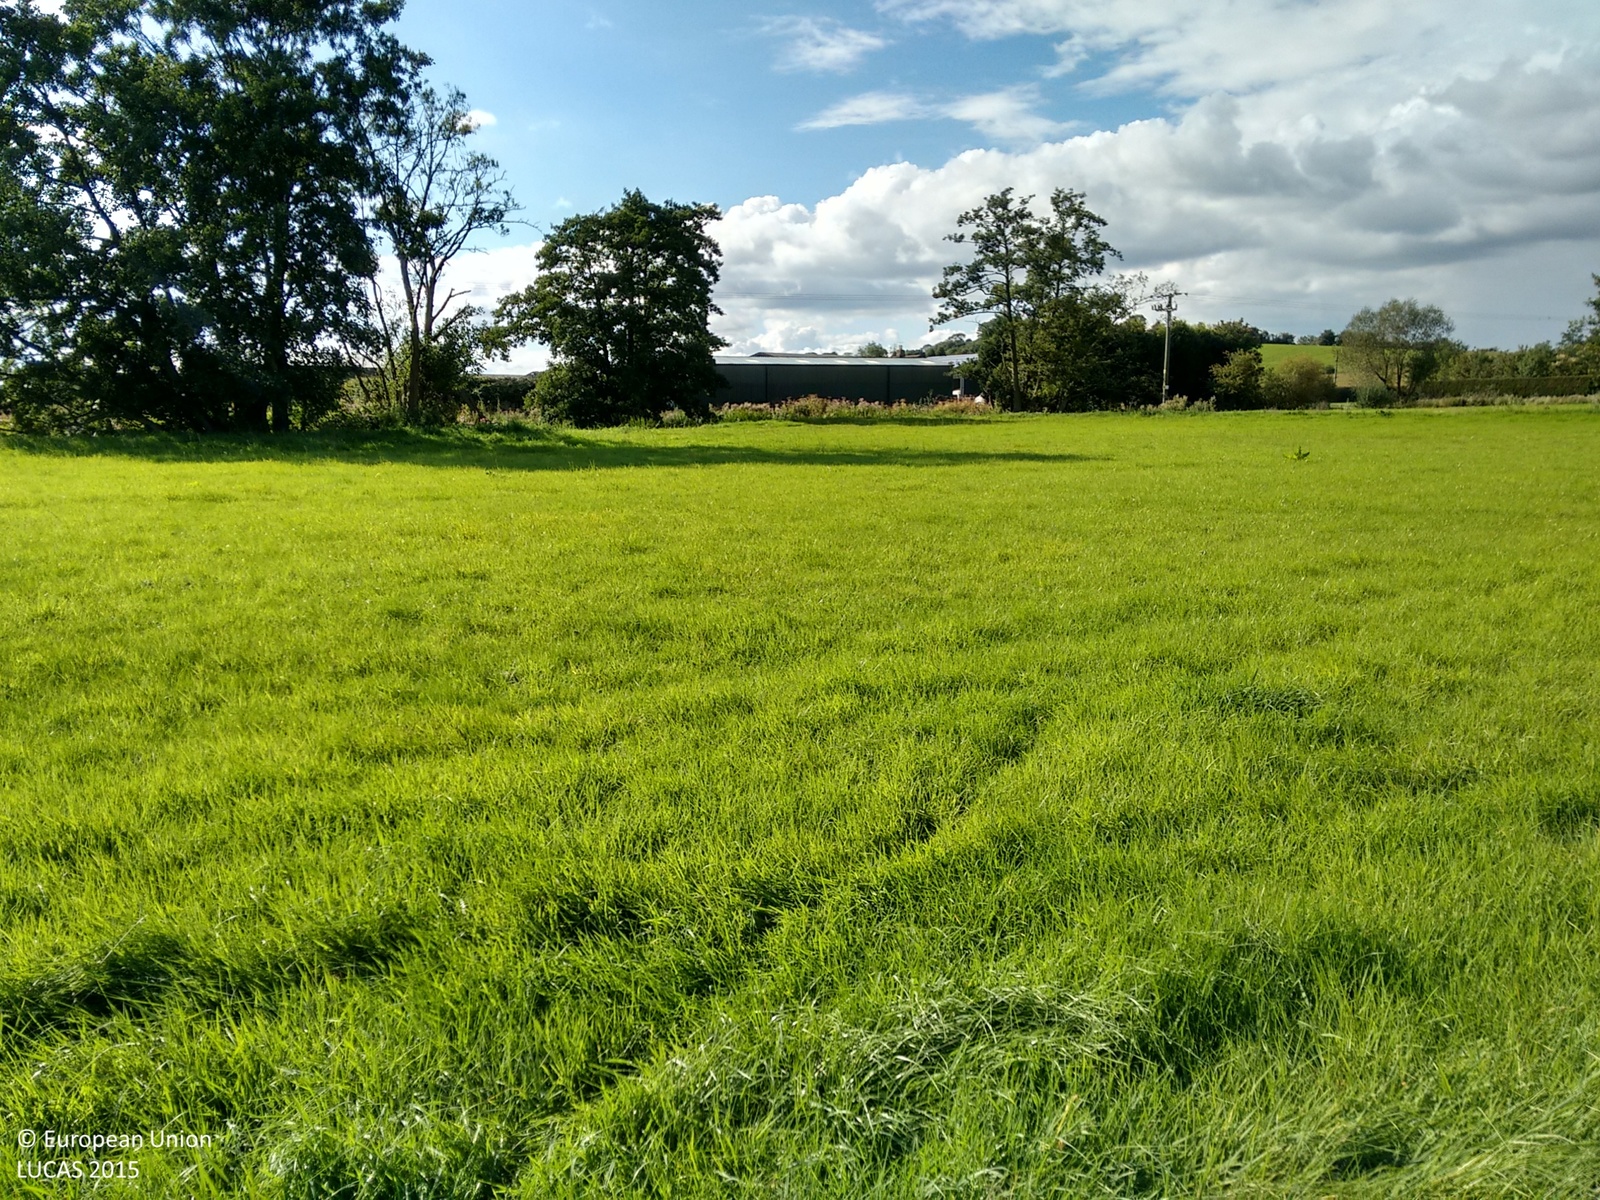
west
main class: Grassland
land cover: Grassland without tree/shrub cover
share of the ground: > 75 %
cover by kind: herbaceous plants 100 %
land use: Agriculture (excluding fallow land and kitchen gardens)
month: September
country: GB
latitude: 52.7643
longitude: -1.8375
